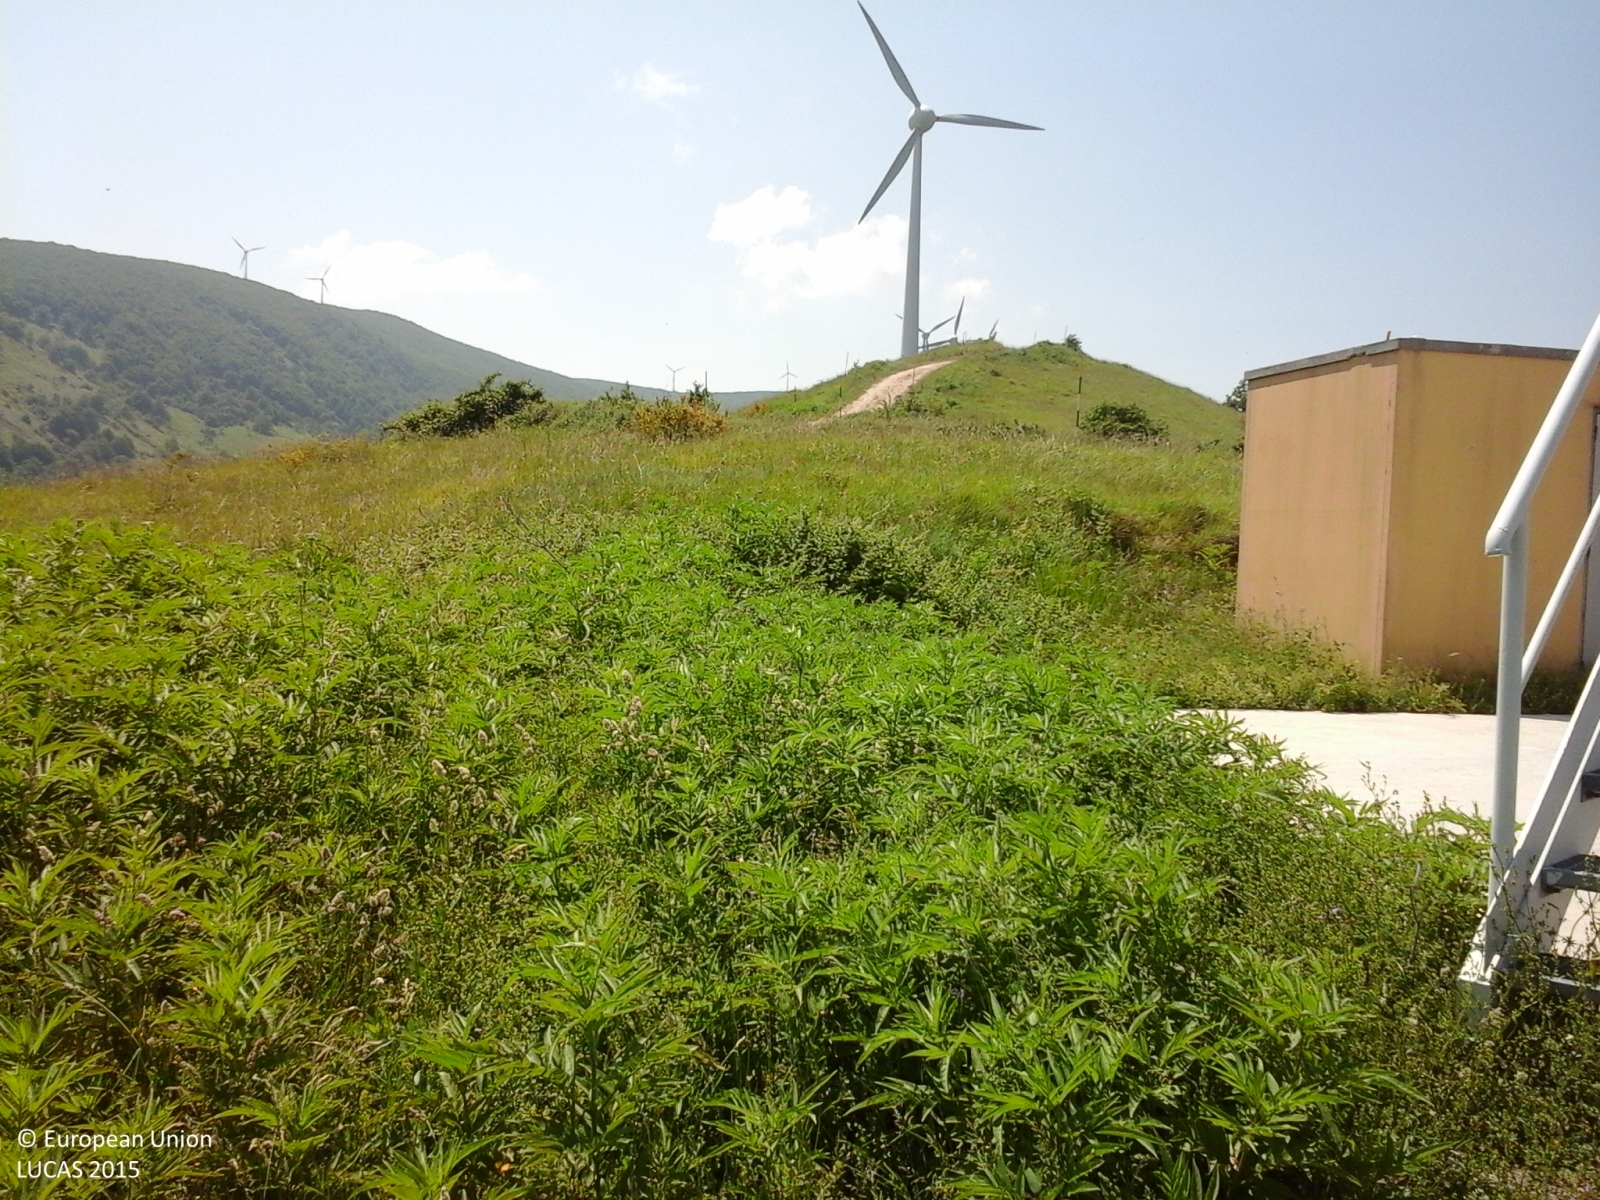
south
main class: Grassland
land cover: Grassland without tree/shrub cover
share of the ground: > 75 %
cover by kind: herbaceous plants 100 %
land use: Energy production
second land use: Agriculture (excluding fallow land and kitchen gardens)
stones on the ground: 10 - 25 %
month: June
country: IT
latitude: 41.9439
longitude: 14.3884
